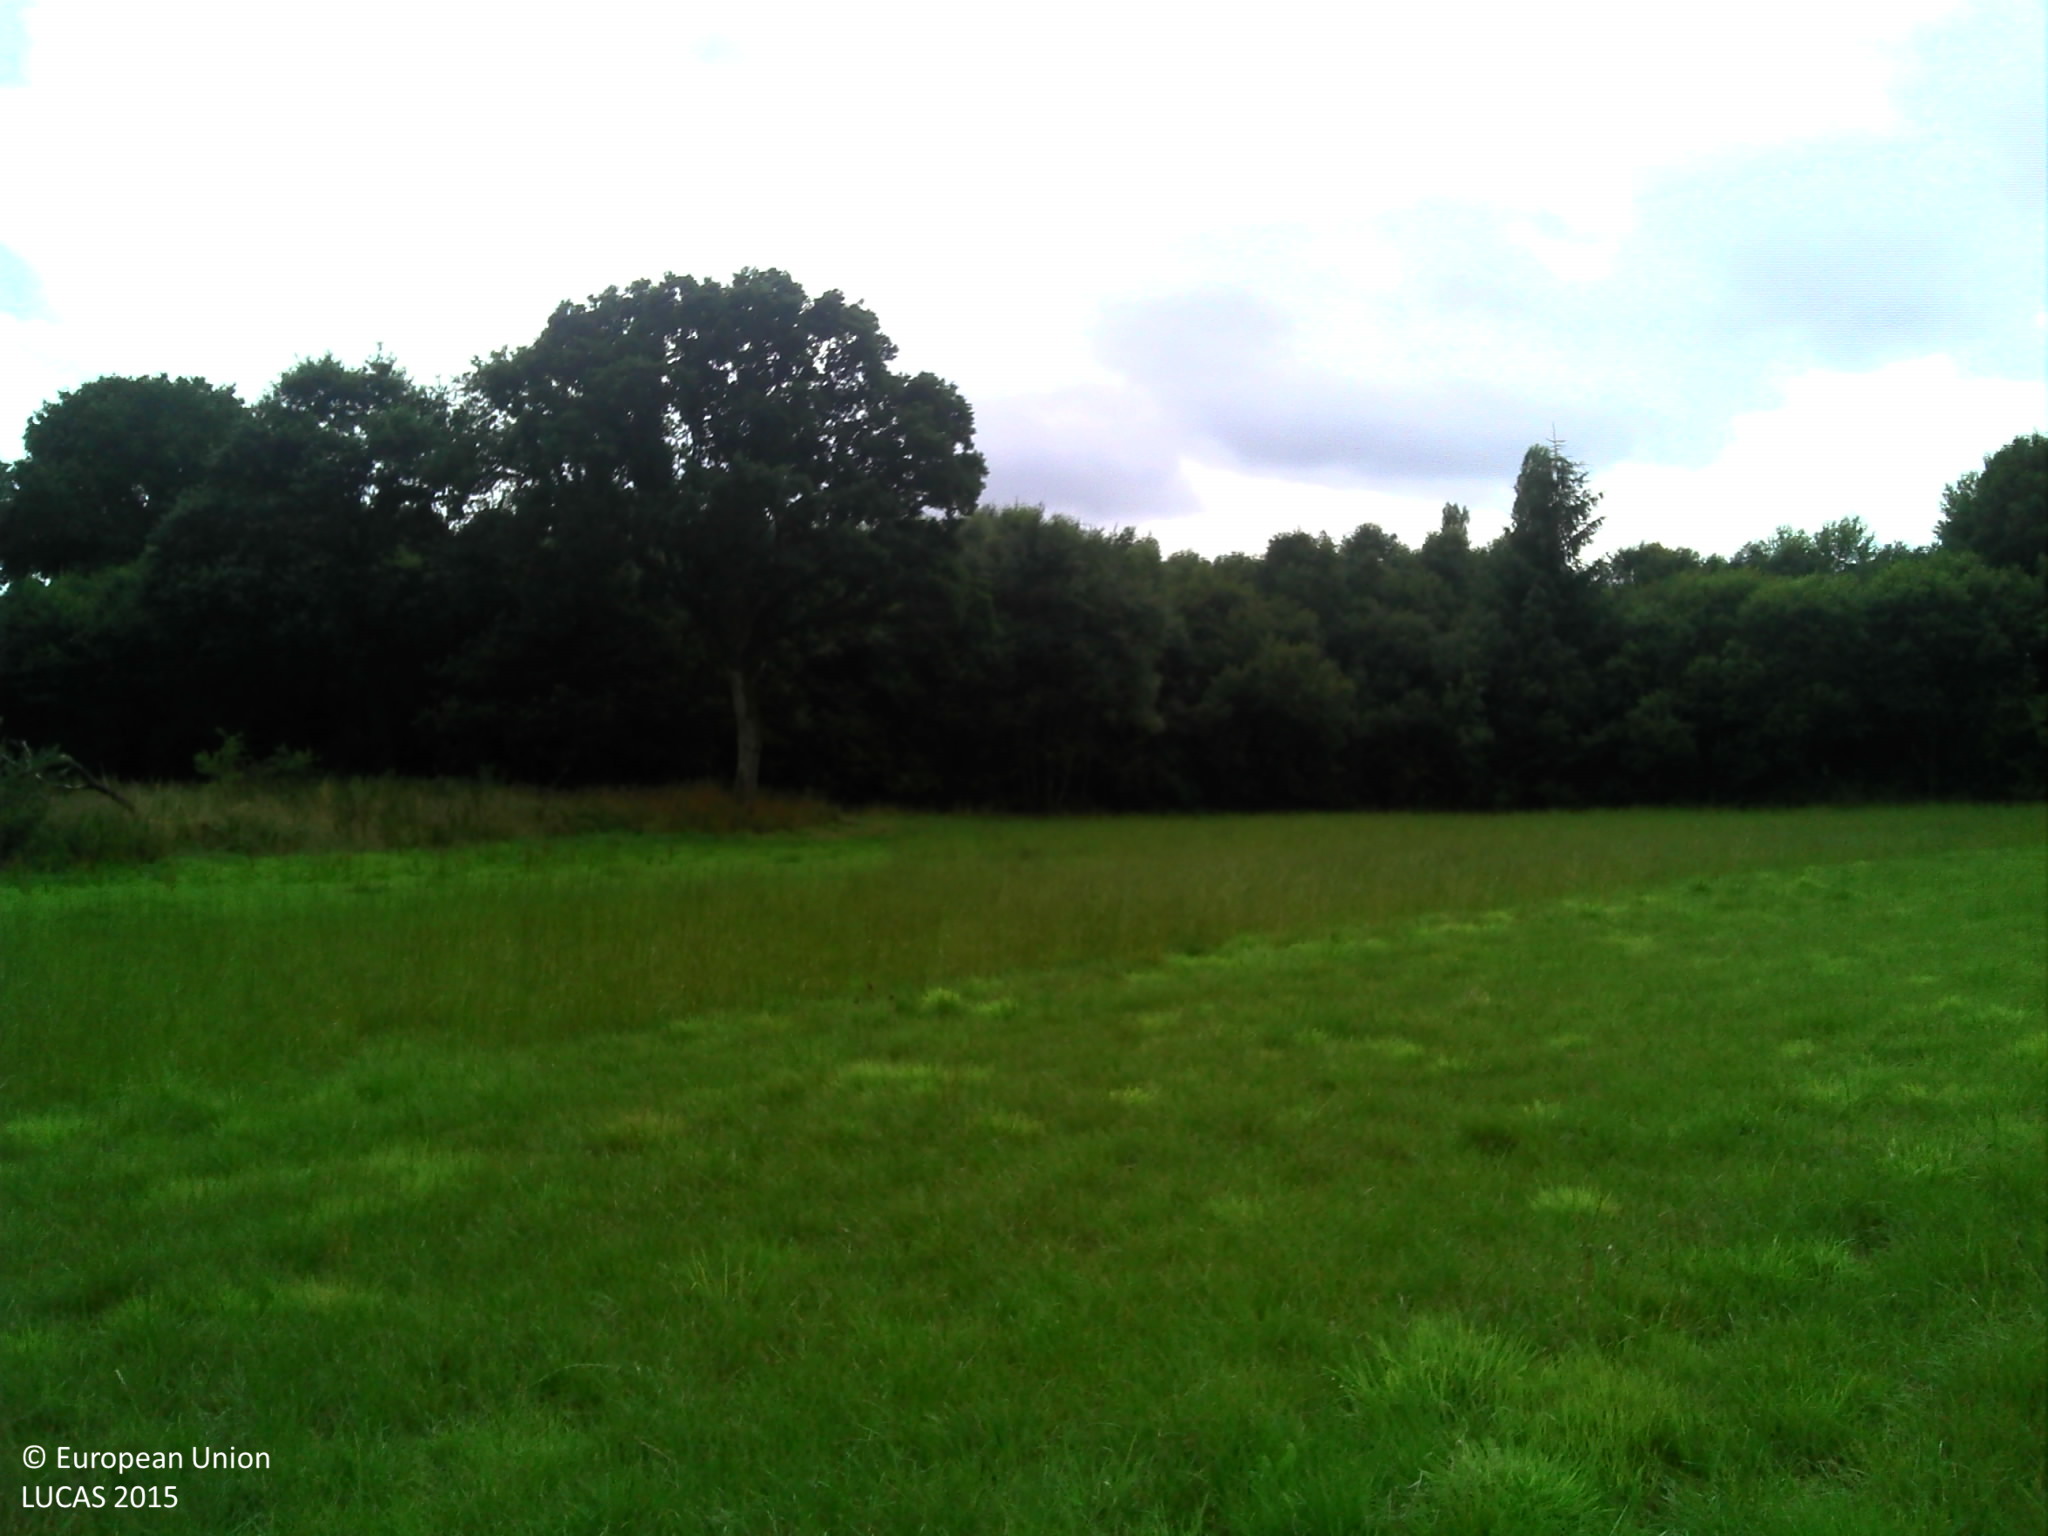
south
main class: Cropland
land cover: Temporary grasslands
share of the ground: > 75 %
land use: Agriculture (excluding fallow land and kitchen gardens)
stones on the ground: < 10 %
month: August
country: FR
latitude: 48.2937
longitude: -3.4072
